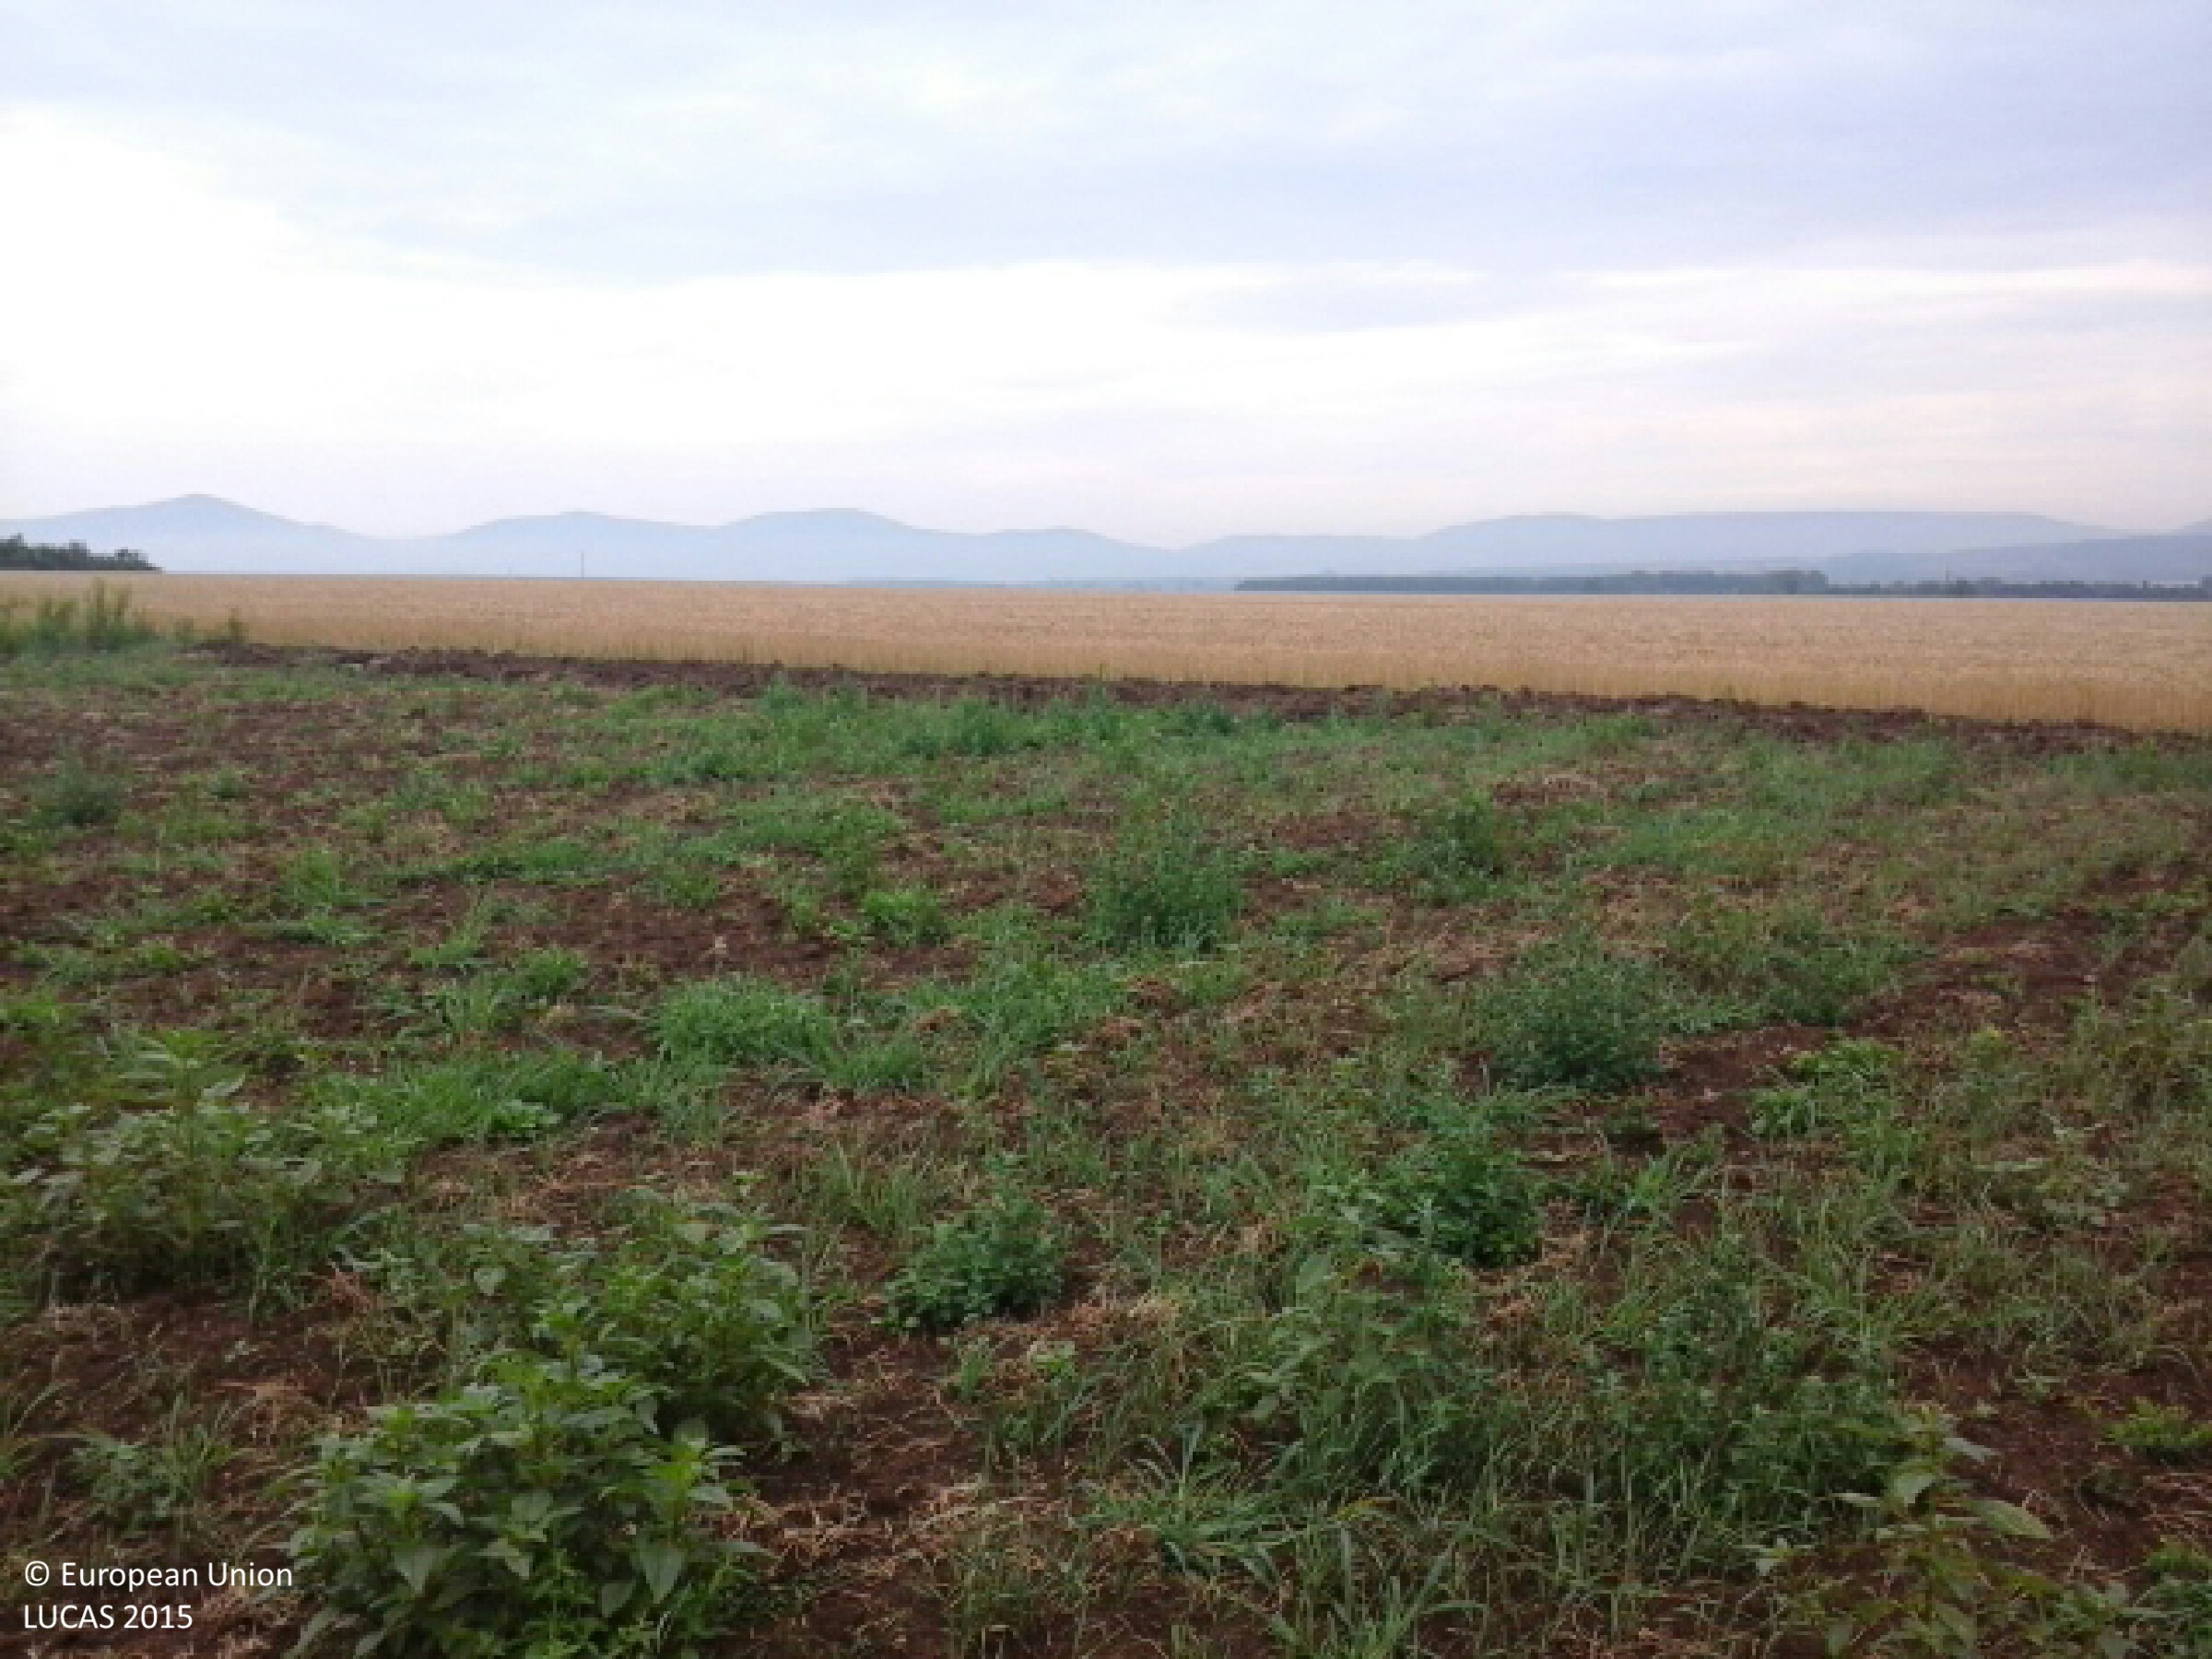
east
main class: Grassland
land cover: Spontaneously vegetated surfaces
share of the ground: 10 - 25 %
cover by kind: herbaceous plants 60 %, consolidated bare surface 40 %
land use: Fallow land
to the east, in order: Spontaneously vegetated surfaces; Tracks; Triticale
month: July
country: HU
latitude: 48.3342
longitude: 21.0893
